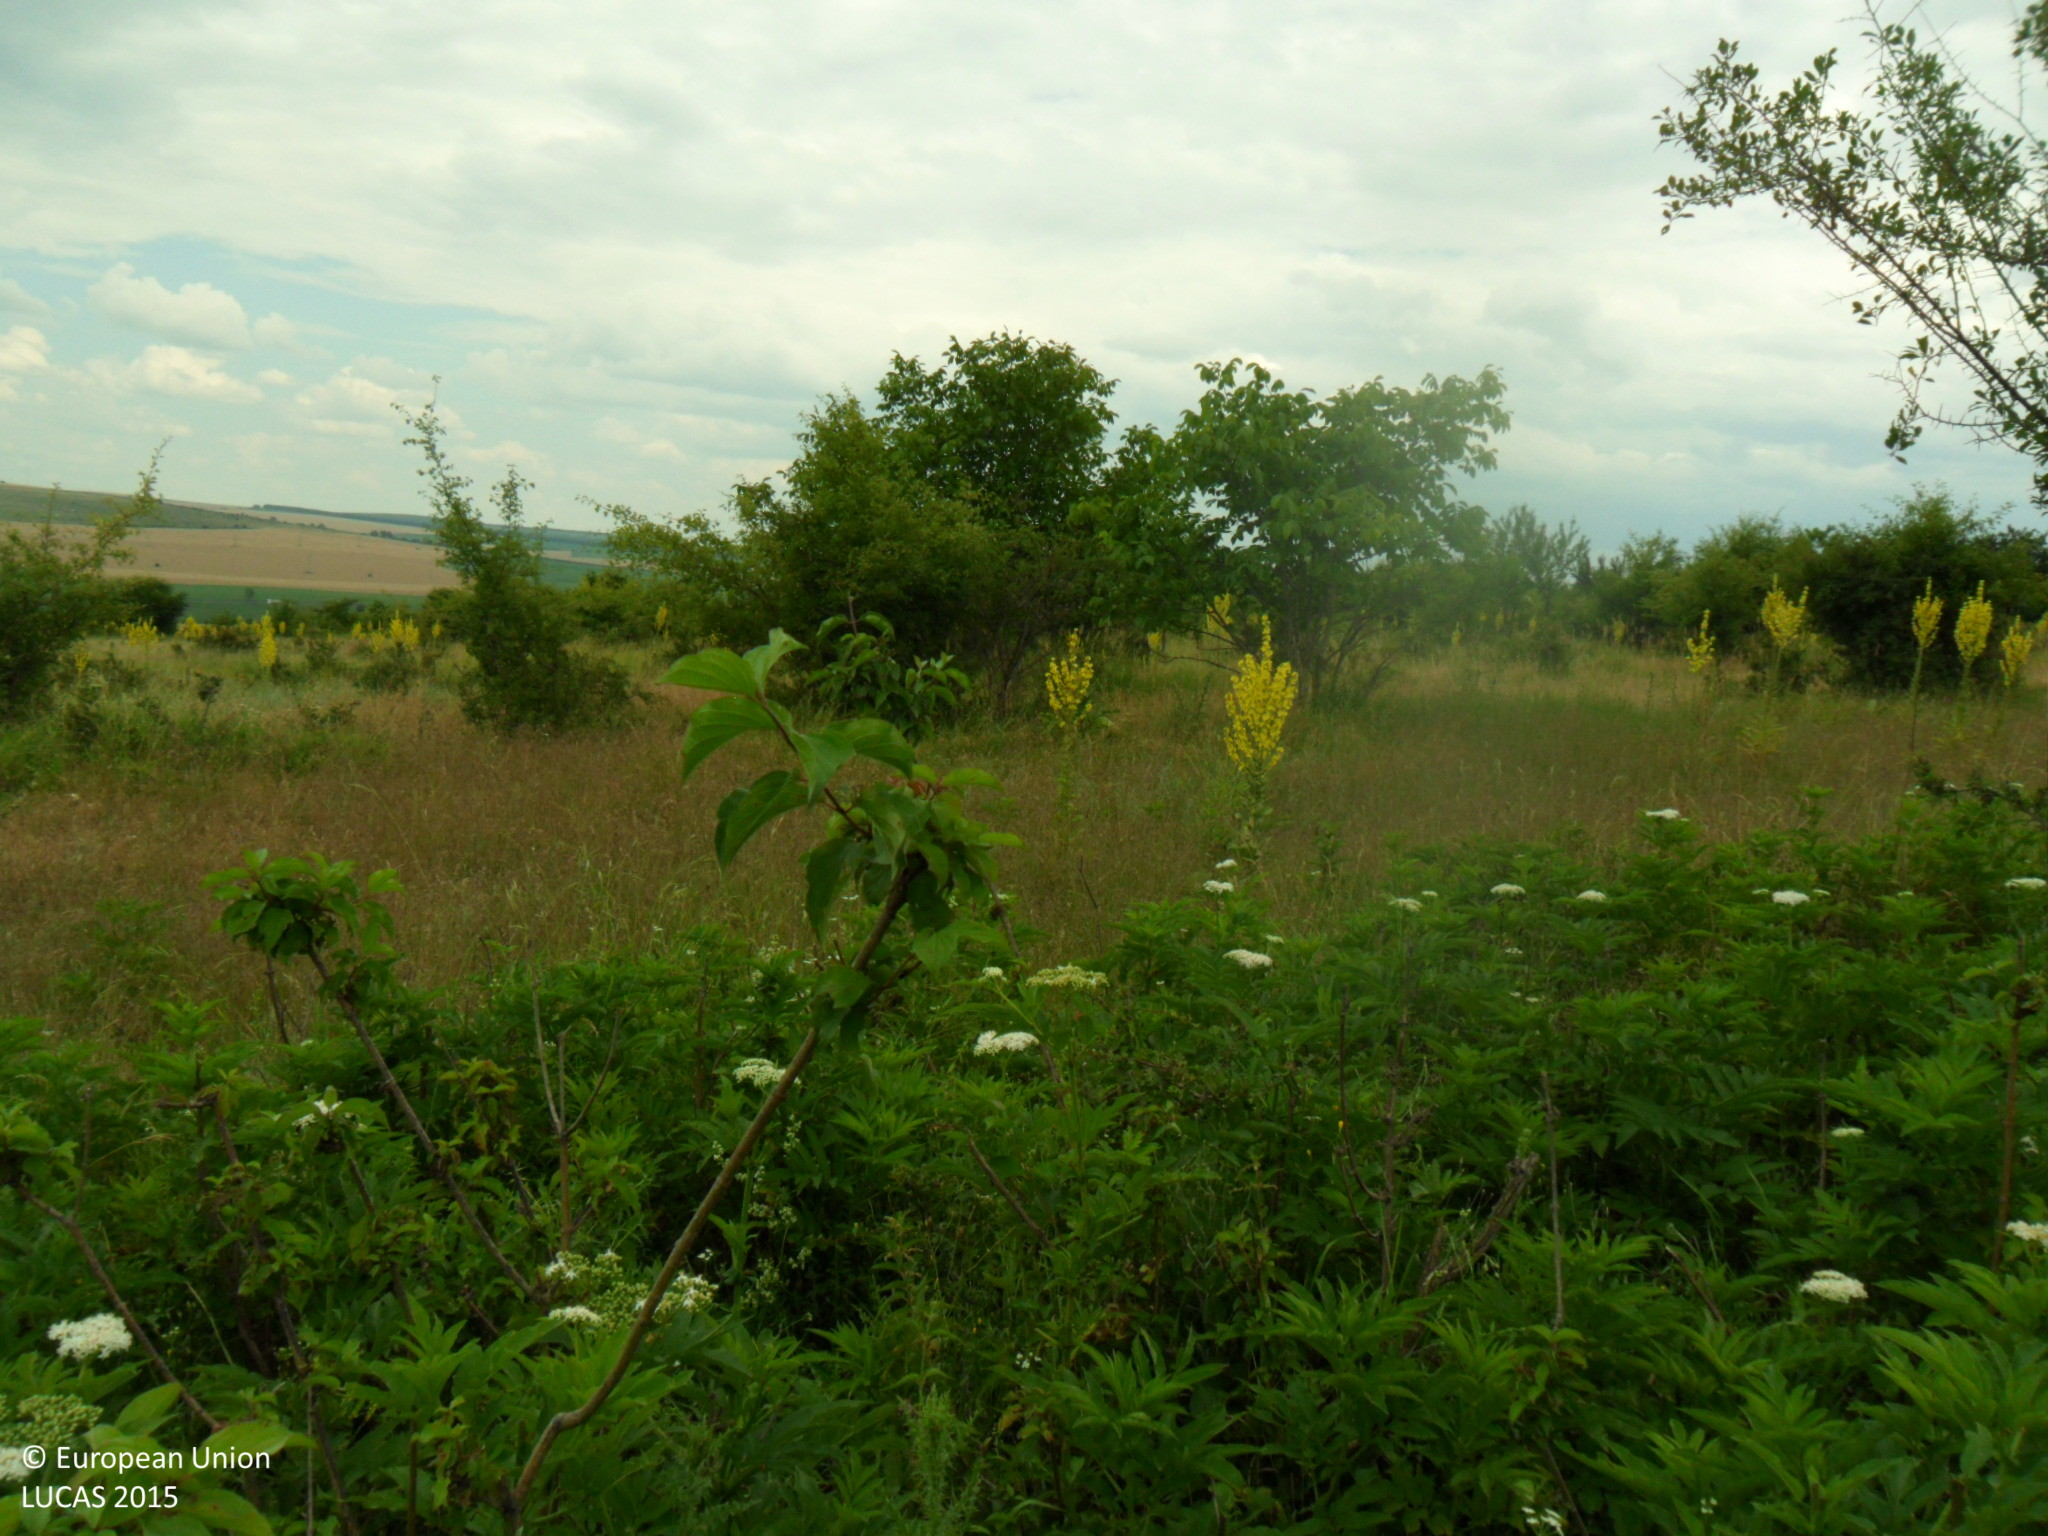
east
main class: Shrubland
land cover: Shrubland with sparse tree cover
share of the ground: > 75 %
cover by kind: herbaceous plants 60 %, shrubs 35 %, broadleaved forest trees 5 %
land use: Agriculture (excluding fallow land and kitchen gardens)
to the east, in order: Shrubland with sparse tree cover; Grassland without tree/shrub cover; Shruby margins; Grassland without tree/shrub cover; Tracks; Grassland without tree/shrub cover; Shrubland with sparse tree cover; Grass margins; Tracks; Grass margins; Common wheat
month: June
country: BG
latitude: 43.4567
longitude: 26.6309
